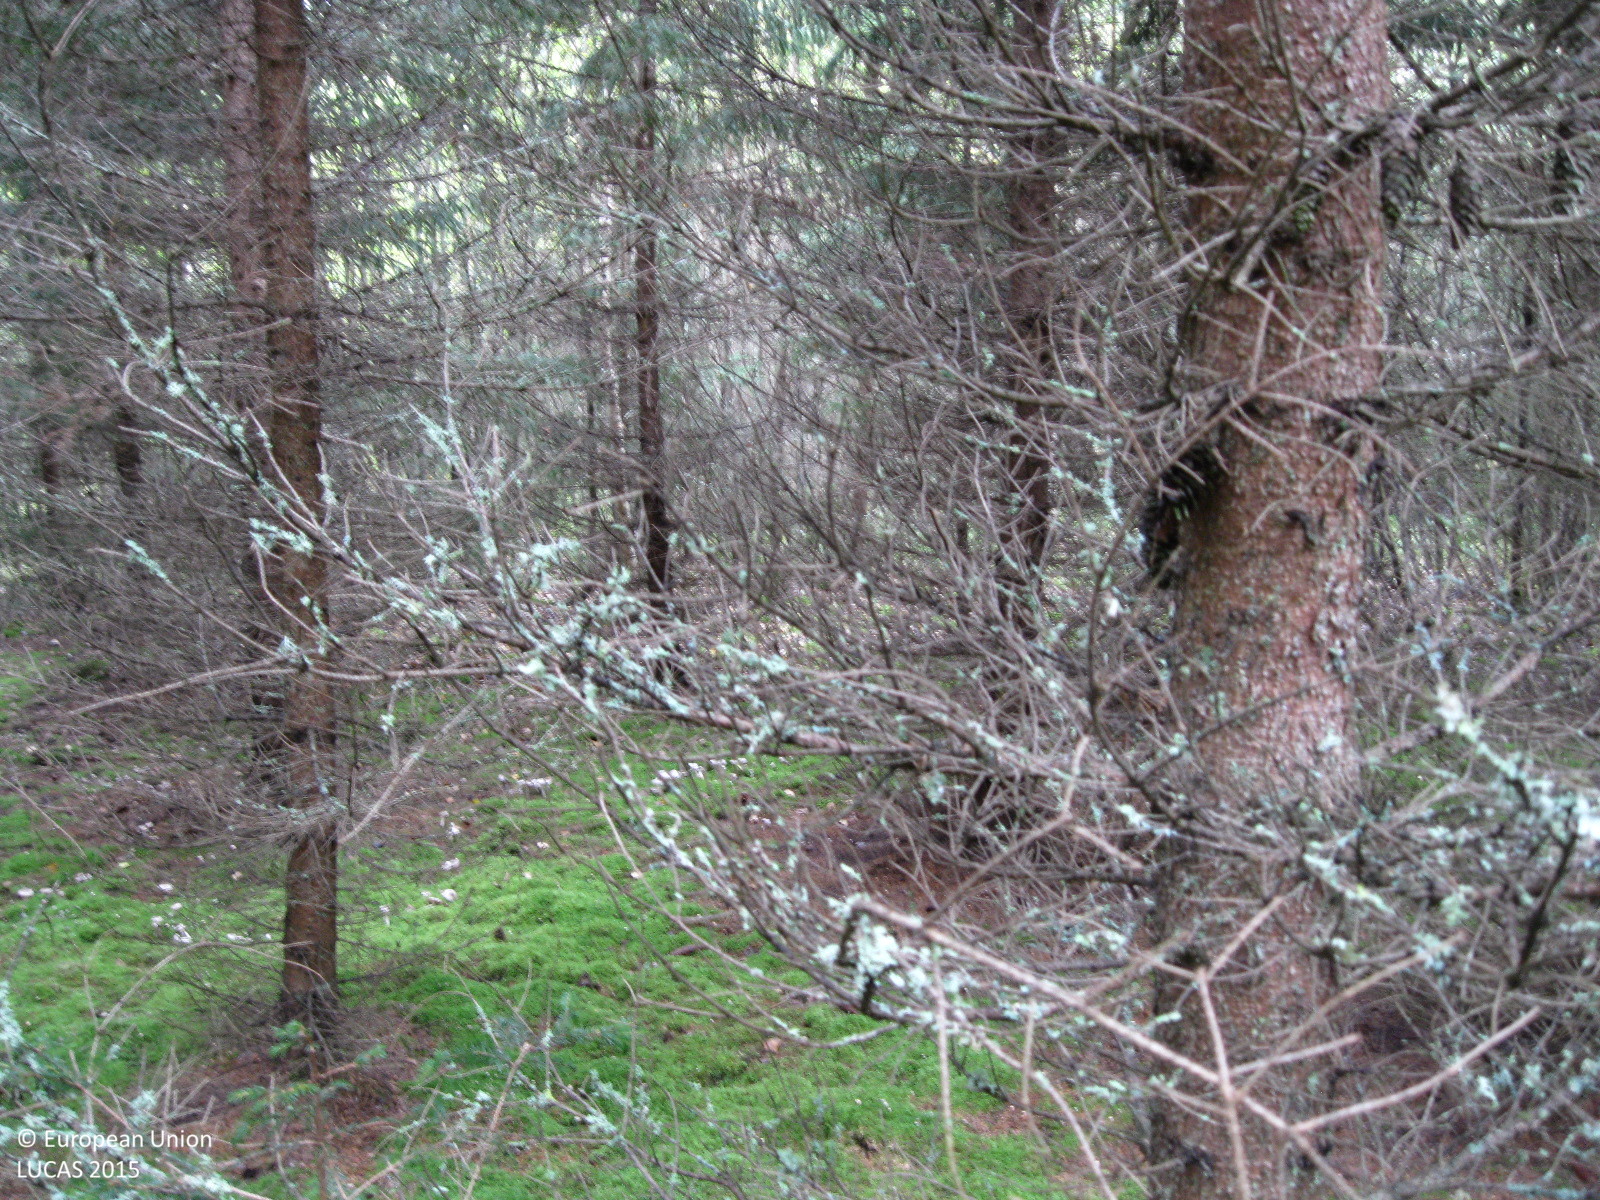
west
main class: Woodland
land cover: Spruce dominated coniferous woodland
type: boreal forest
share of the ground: > 75 %
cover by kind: coniferous forest trees 85 %, lichens and mosses 10 %, herbaceous plants 5 %
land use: Forestry
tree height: > 5 m
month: September
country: FI
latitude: 60.3888
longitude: 24.2353
